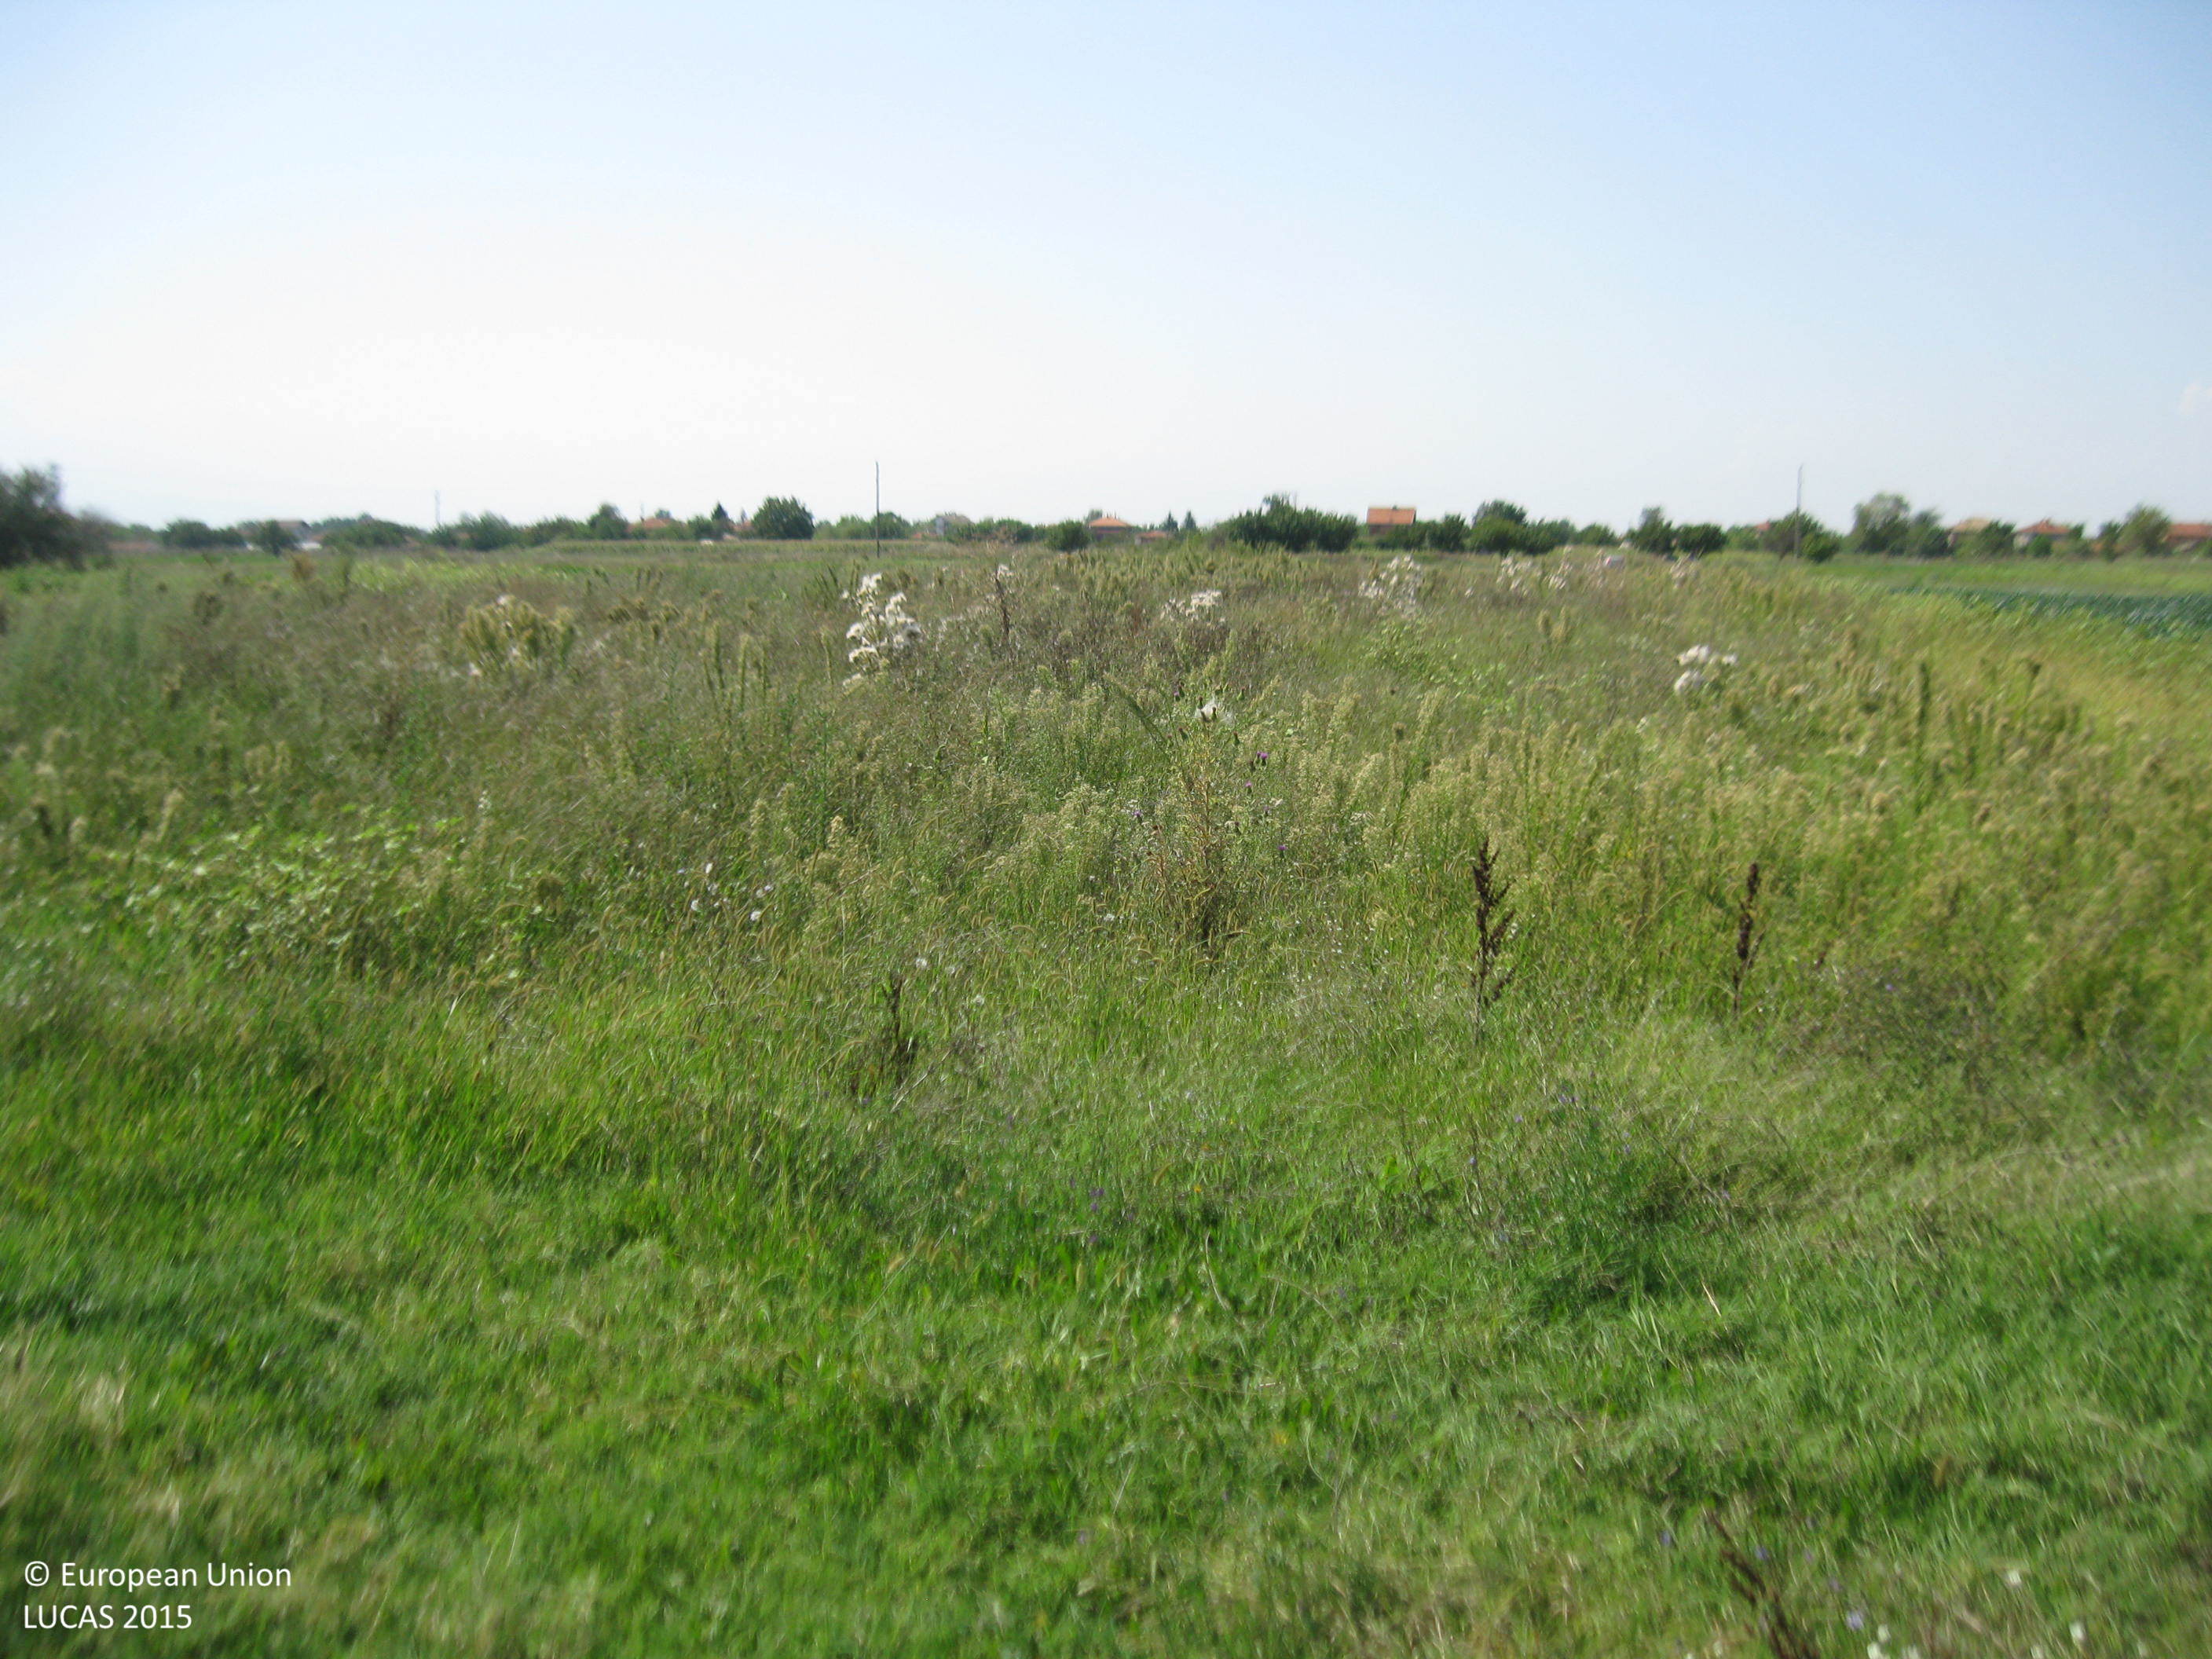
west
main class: Cropland
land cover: Lucerne
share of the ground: > 75 %
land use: Agriculture (excluding fallow land and kitchen gardens)
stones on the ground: < 10 %
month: September
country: BG
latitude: 42.2343
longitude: 24.9484
